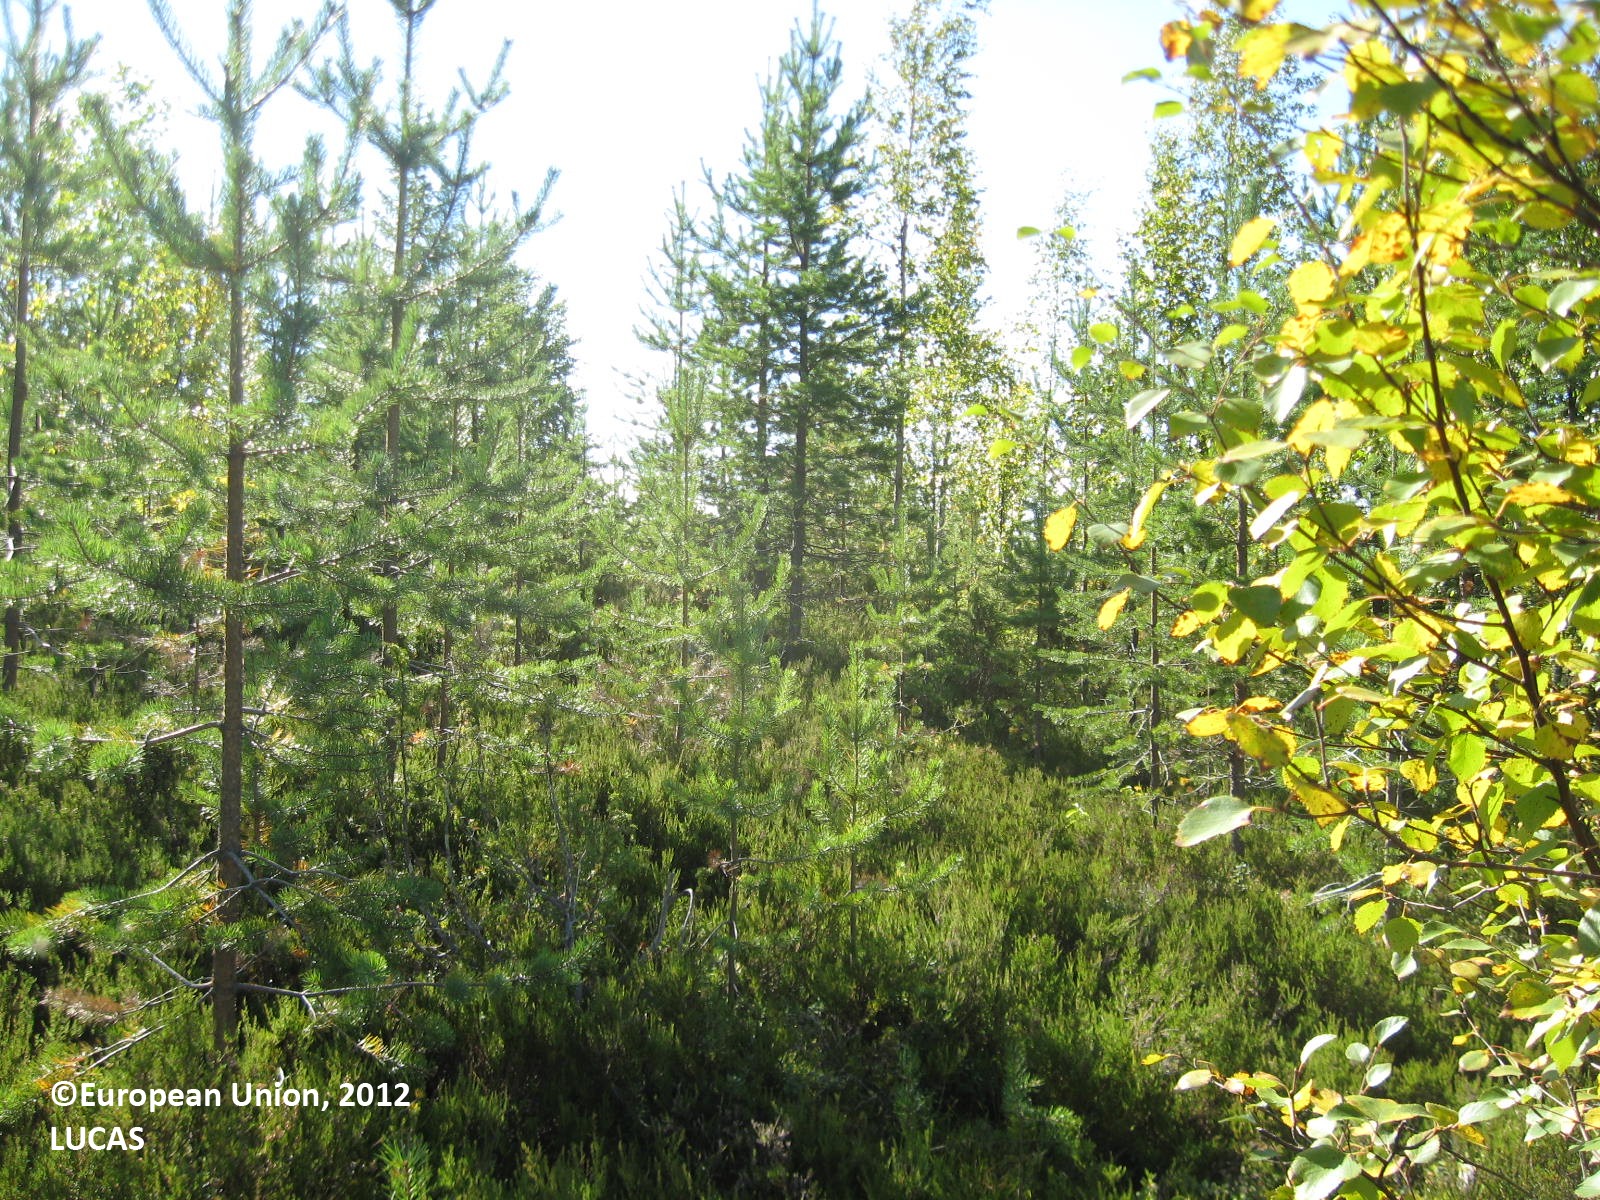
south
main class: Woodland
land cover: Other mixed woodland
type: boreal forest
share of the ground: 50 - 75 %
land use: Forestry
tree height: < 5 m
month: August
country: FI
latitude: 63.7689
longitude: 29.3400
